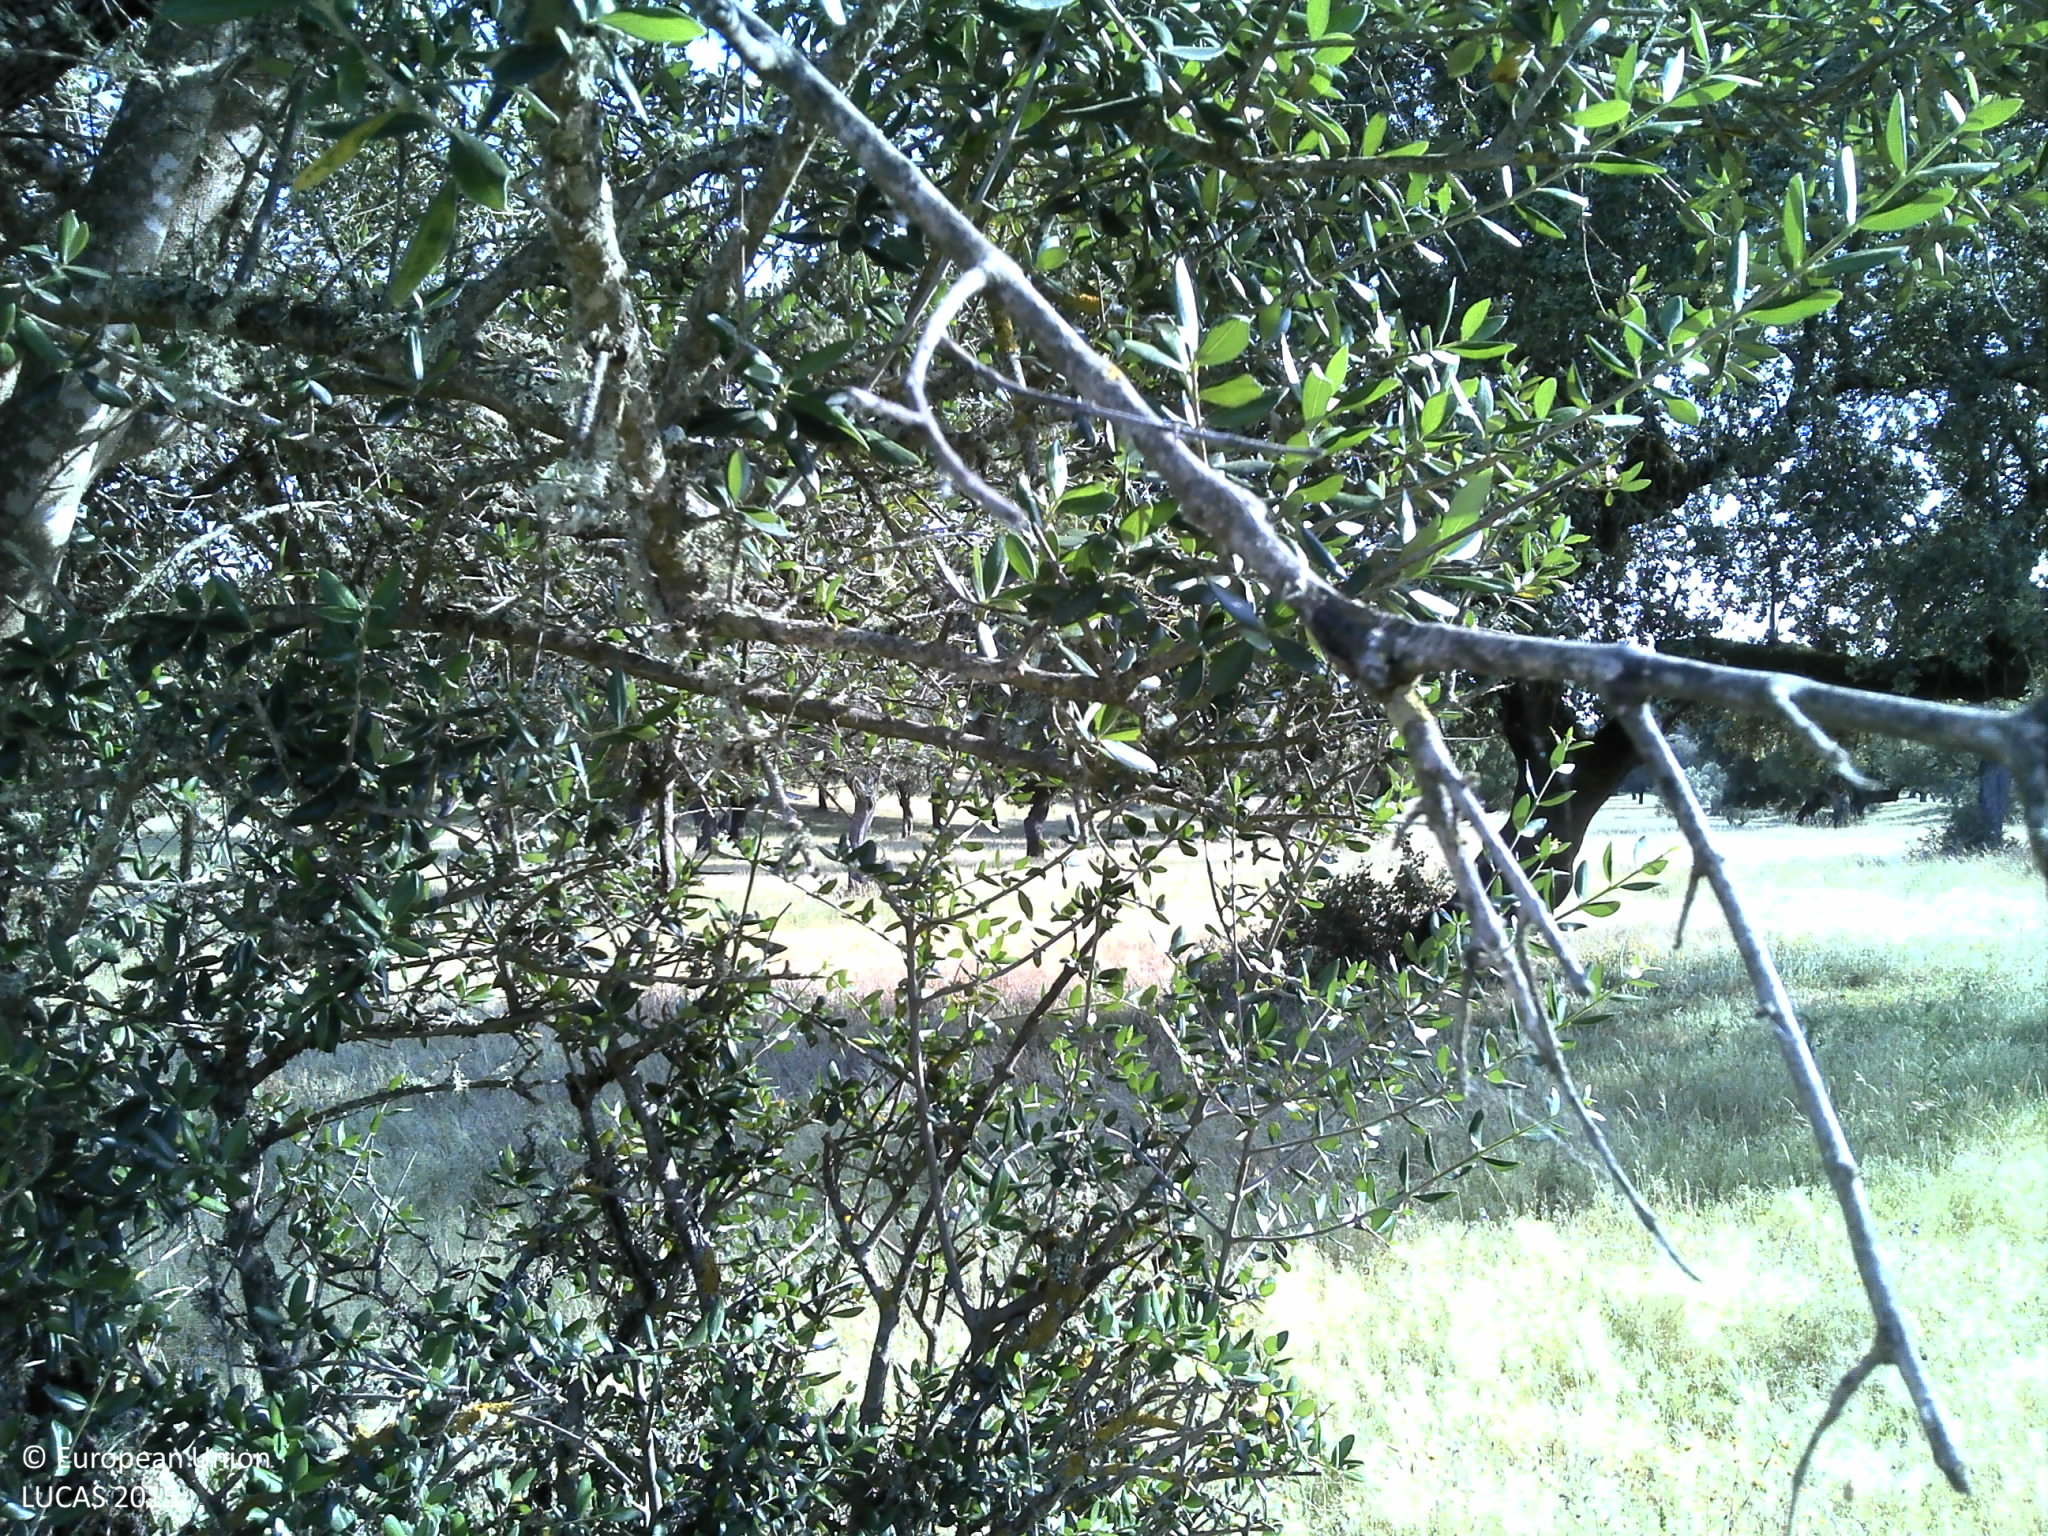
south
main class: Woodland
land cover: Broadleaved woodland
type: broadleaved evergreen forest
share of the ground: 10 - 25 %
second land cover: Grassland without tree/shrub cover
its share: 10 - 25 %
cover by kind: unconsolidated bare surface 70 %, broadleaved forest trees 15 %, herbaceous plants 15 %
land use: Forestry
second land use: Agriculture (excluding fallow land and kitchen gardens)
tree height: > 5 m
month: May
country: PT
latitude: 39.2011
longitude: -7.6814
